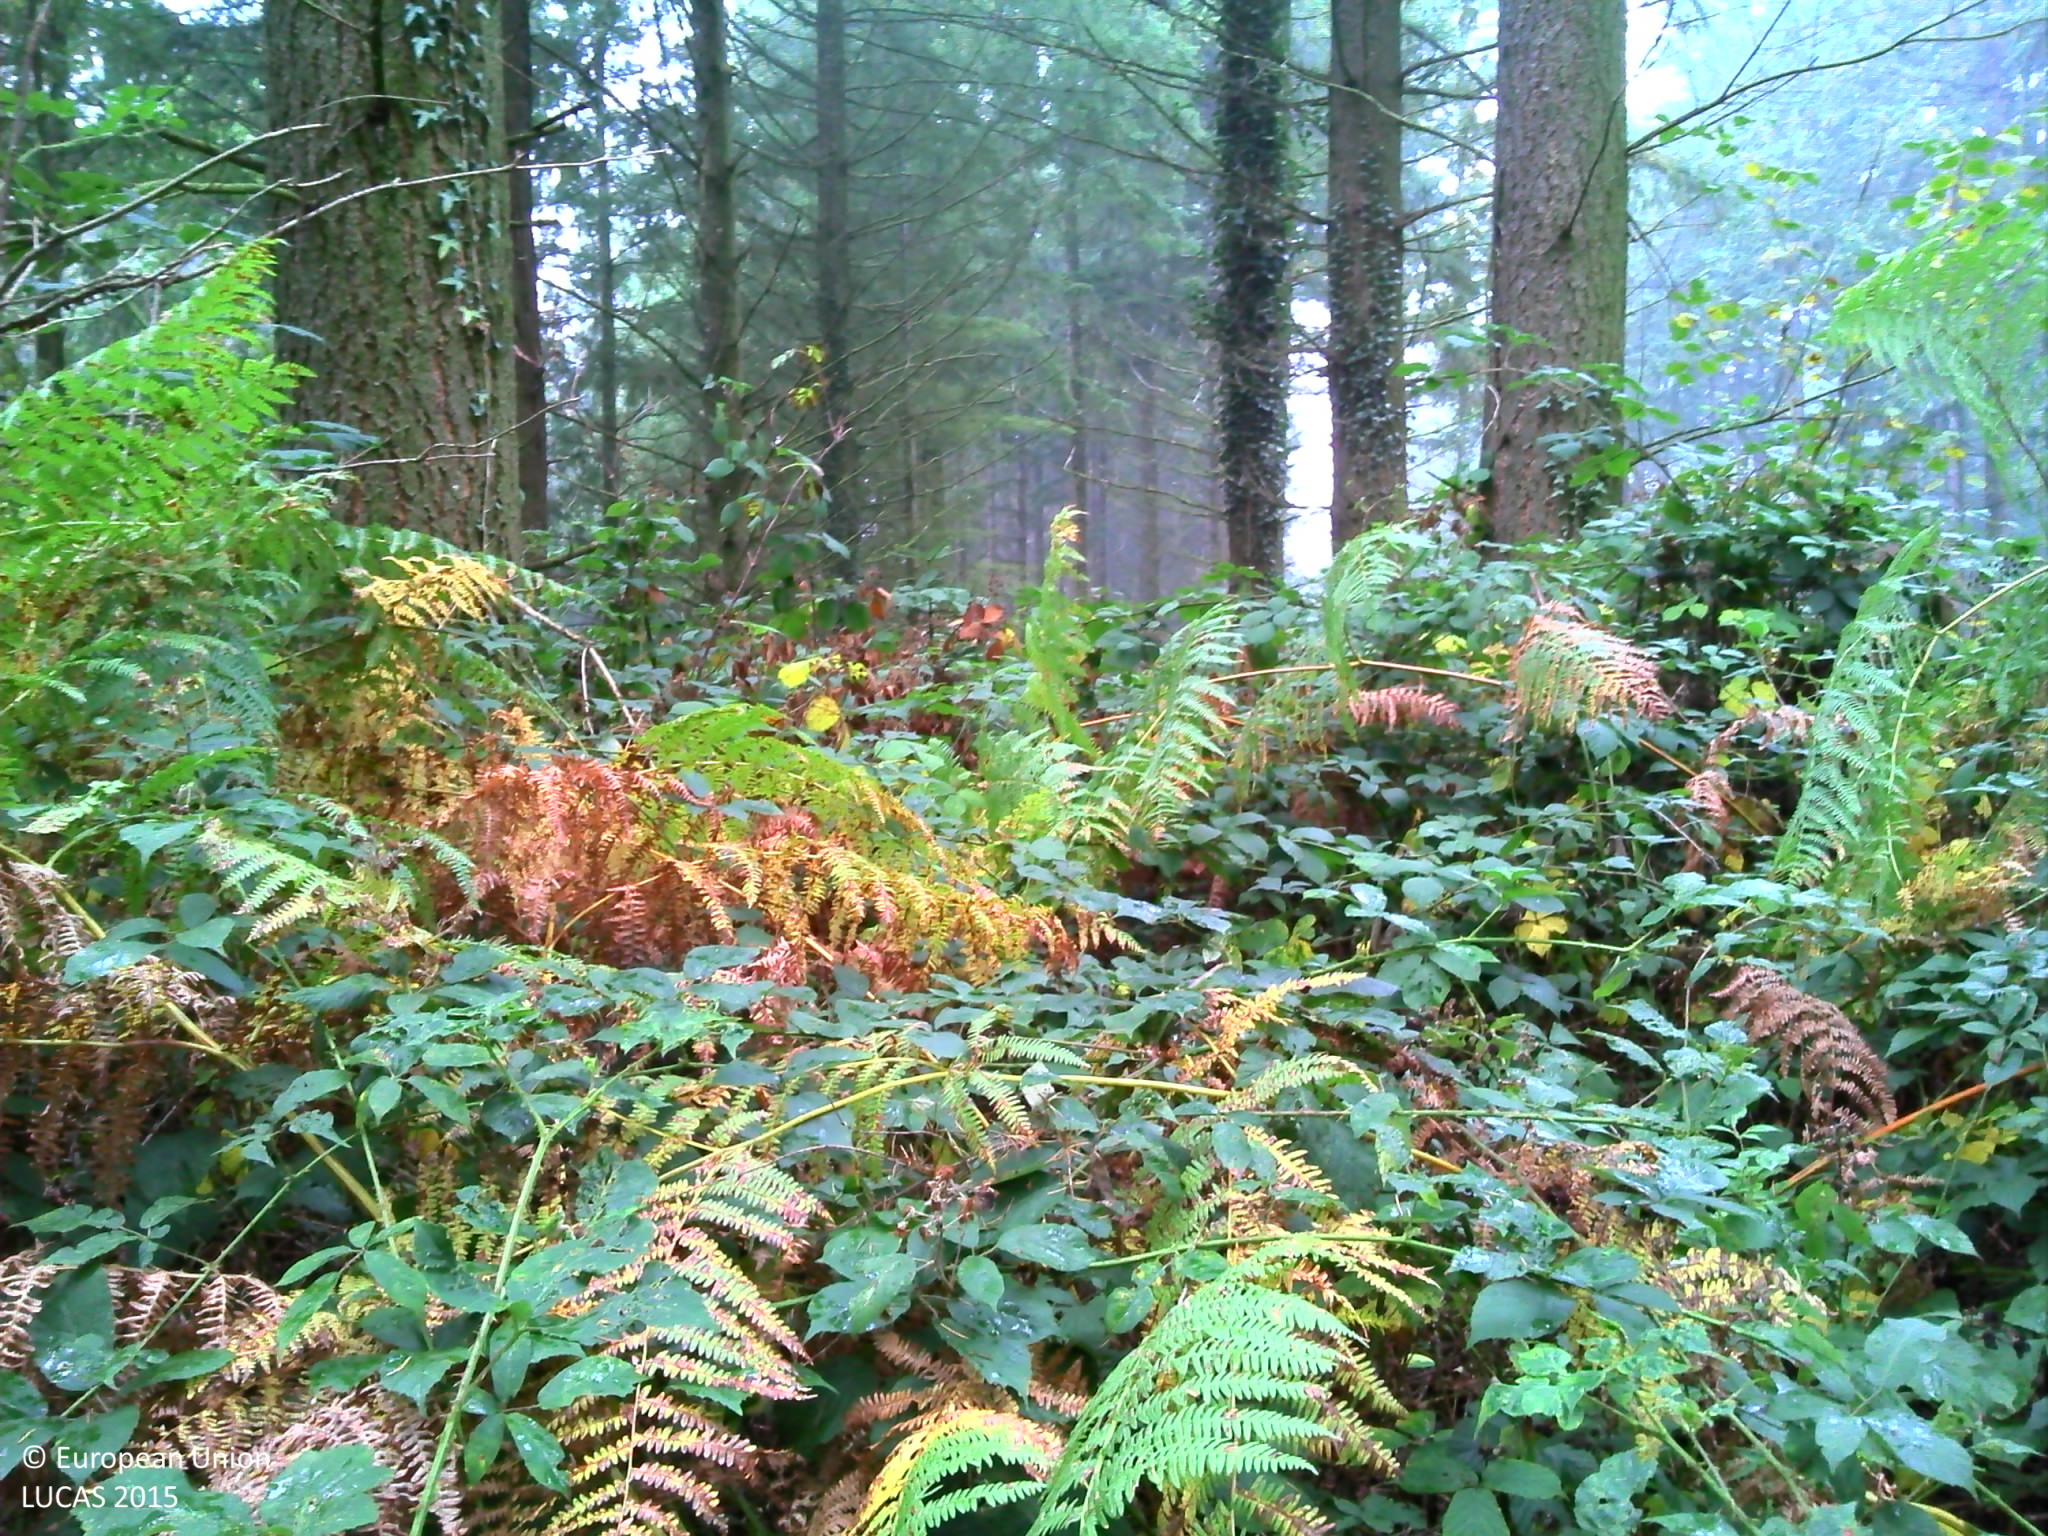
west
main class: Woodland
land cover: Other coniferous woodland
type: exotic forest
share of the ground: 50 - 75 %
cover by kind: coniferous forest trees 65 %, shrubs 20 %, broadleaved forest trees 5 %, herbaceous plants 5 %, lichens and mosses 5 %
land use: Forestry
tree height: > 5 m
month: October
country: FR
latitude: 46.1974
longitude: 2.7793
